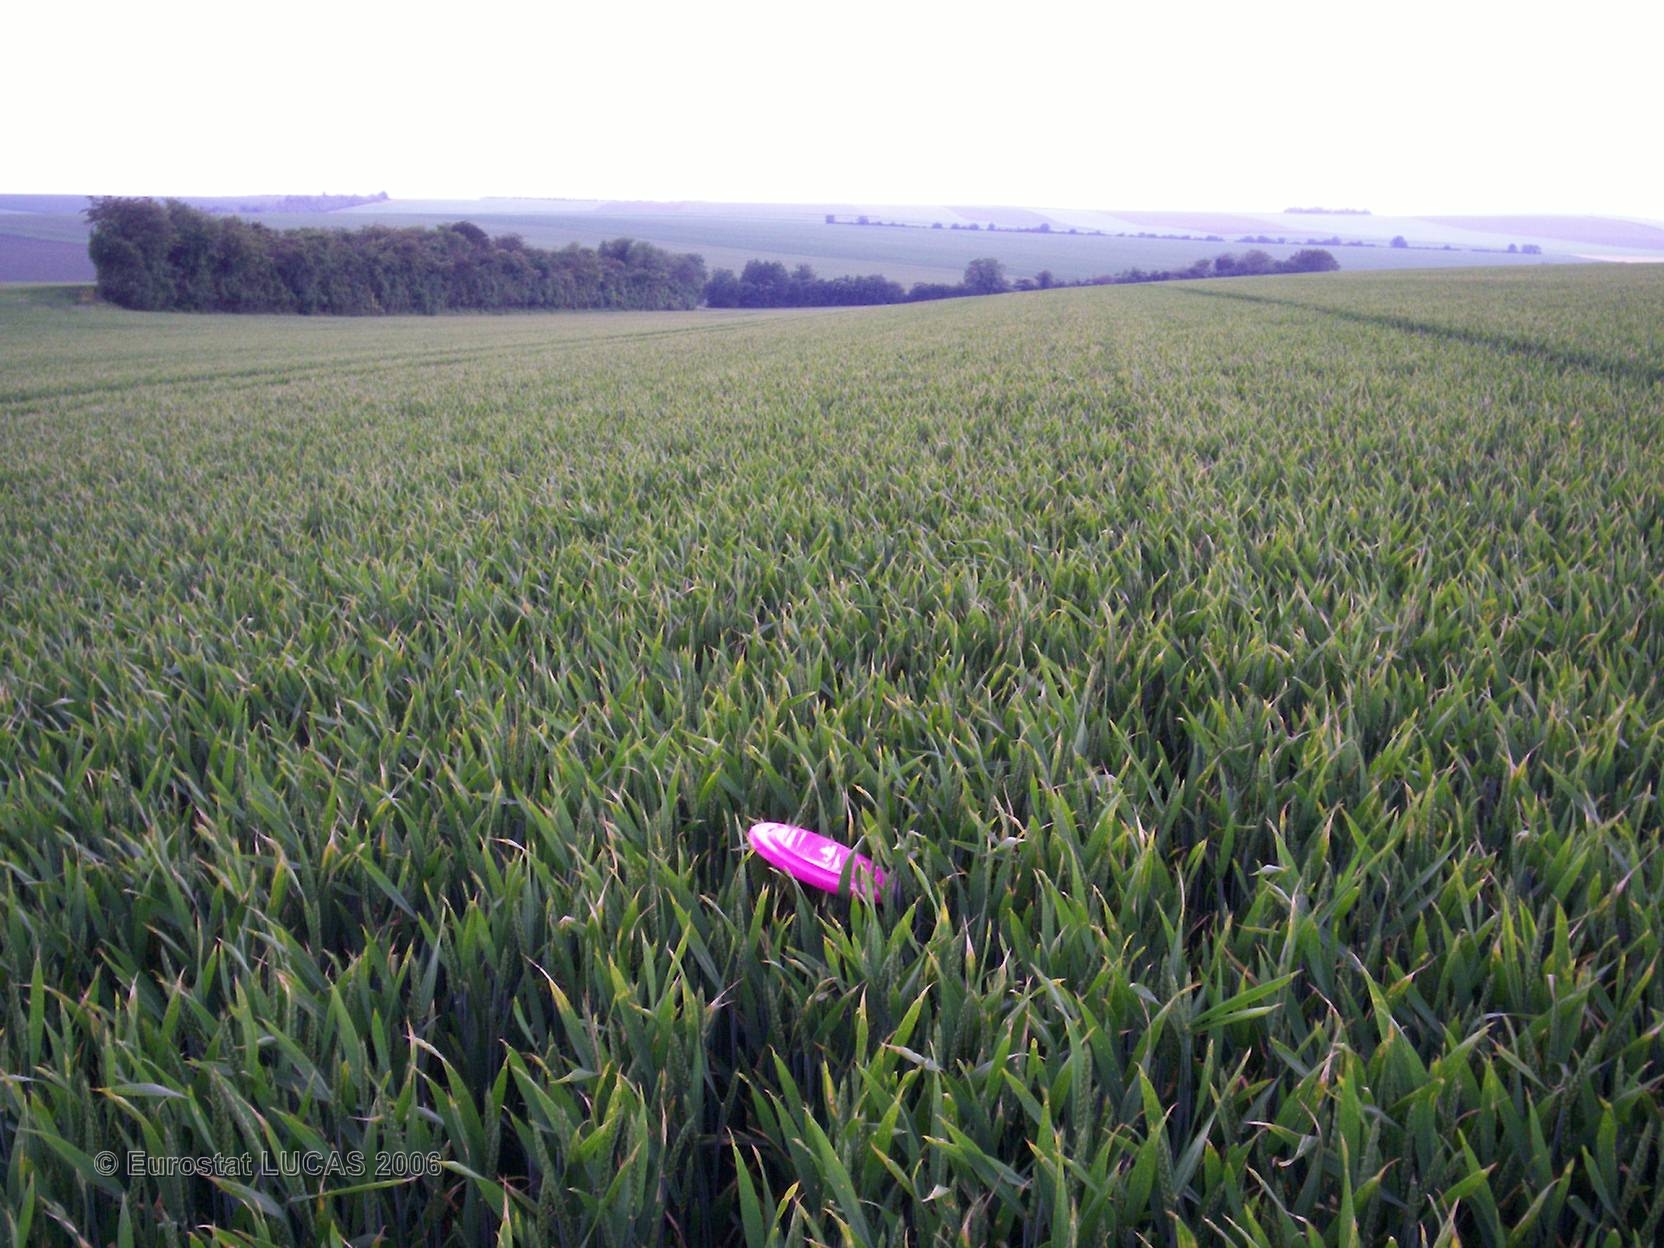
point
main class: Cropland
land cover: Common wheat
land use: Agriculture (excluding fallow land and kitchen gardens)
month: June
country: FR
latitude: 48.6619
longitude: 4.4711
